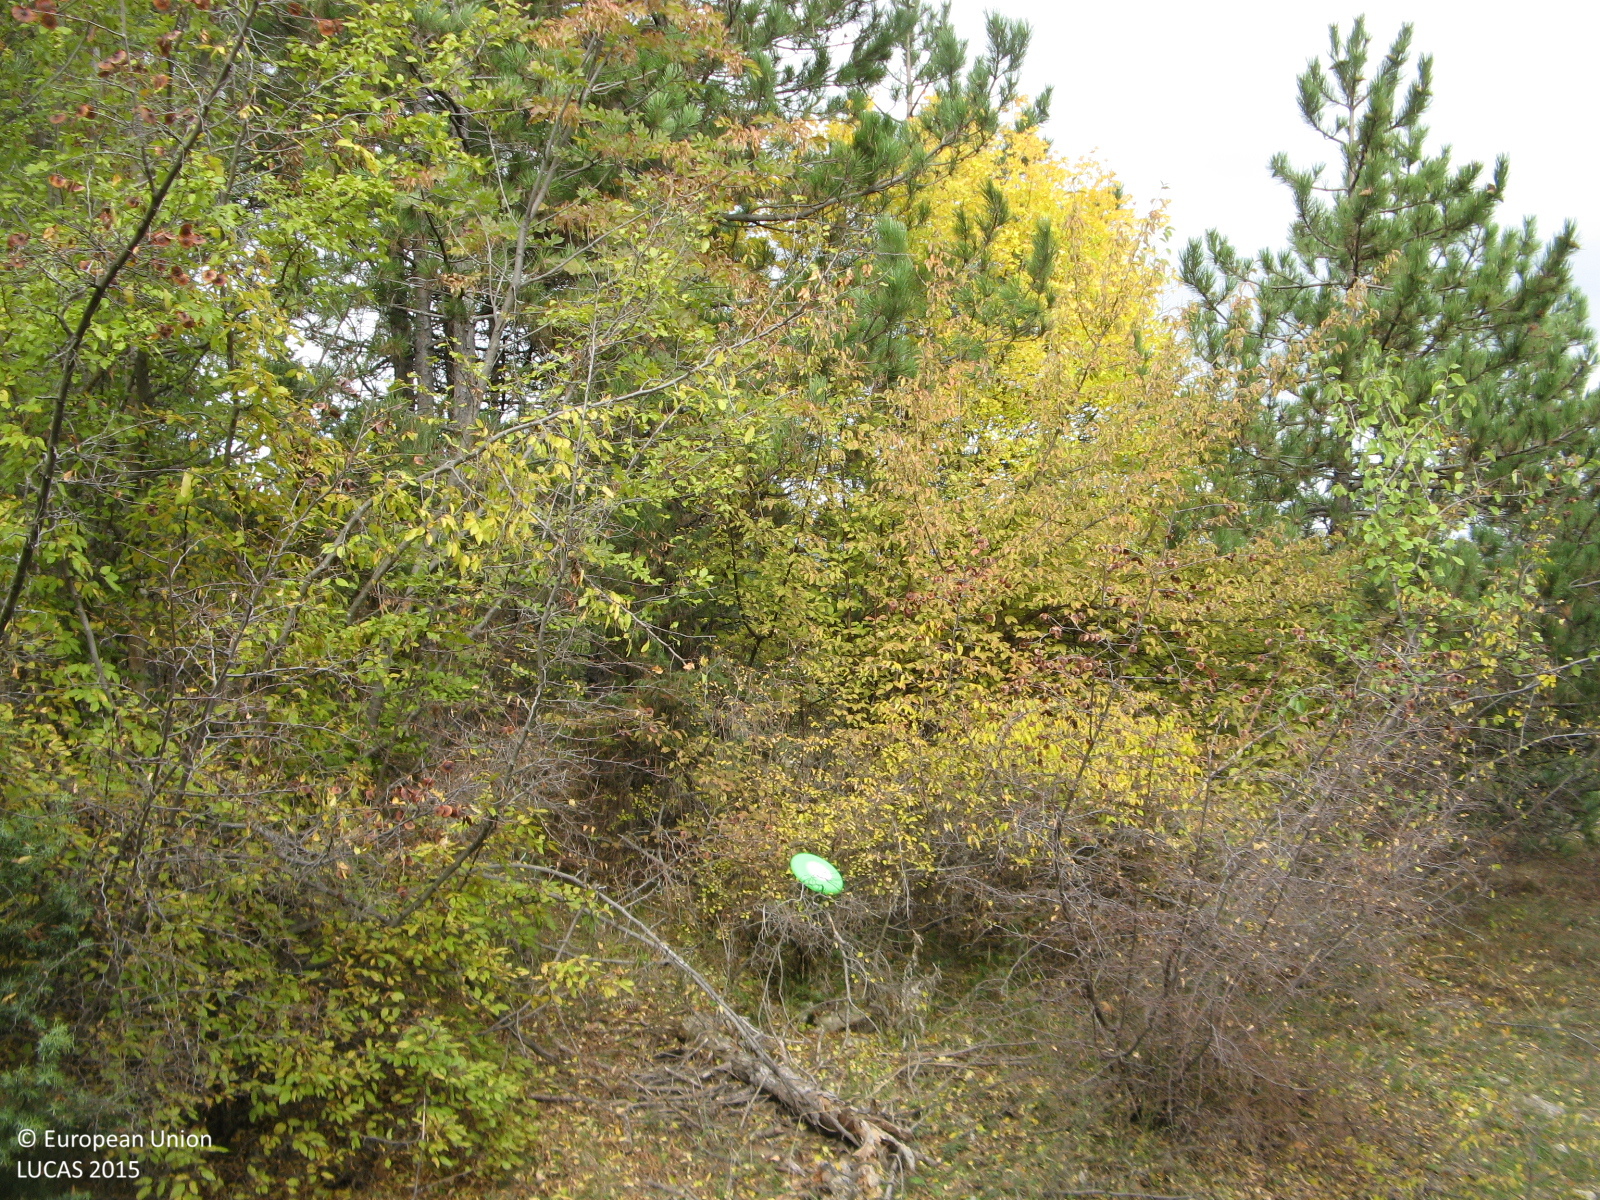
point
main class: Woodland
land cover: Pine dominated mixed woodland
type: hemiboreal forest and nemoral coniferous forest and mixed broadleaved-coniferous forest
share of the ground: > 75 %
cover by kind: coniferous forest trees 75 %, broadleaved forest trees 25 %
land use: Forestry
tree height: > 5 m
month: November
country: BG
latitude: 41.4697
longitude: 25.2716
